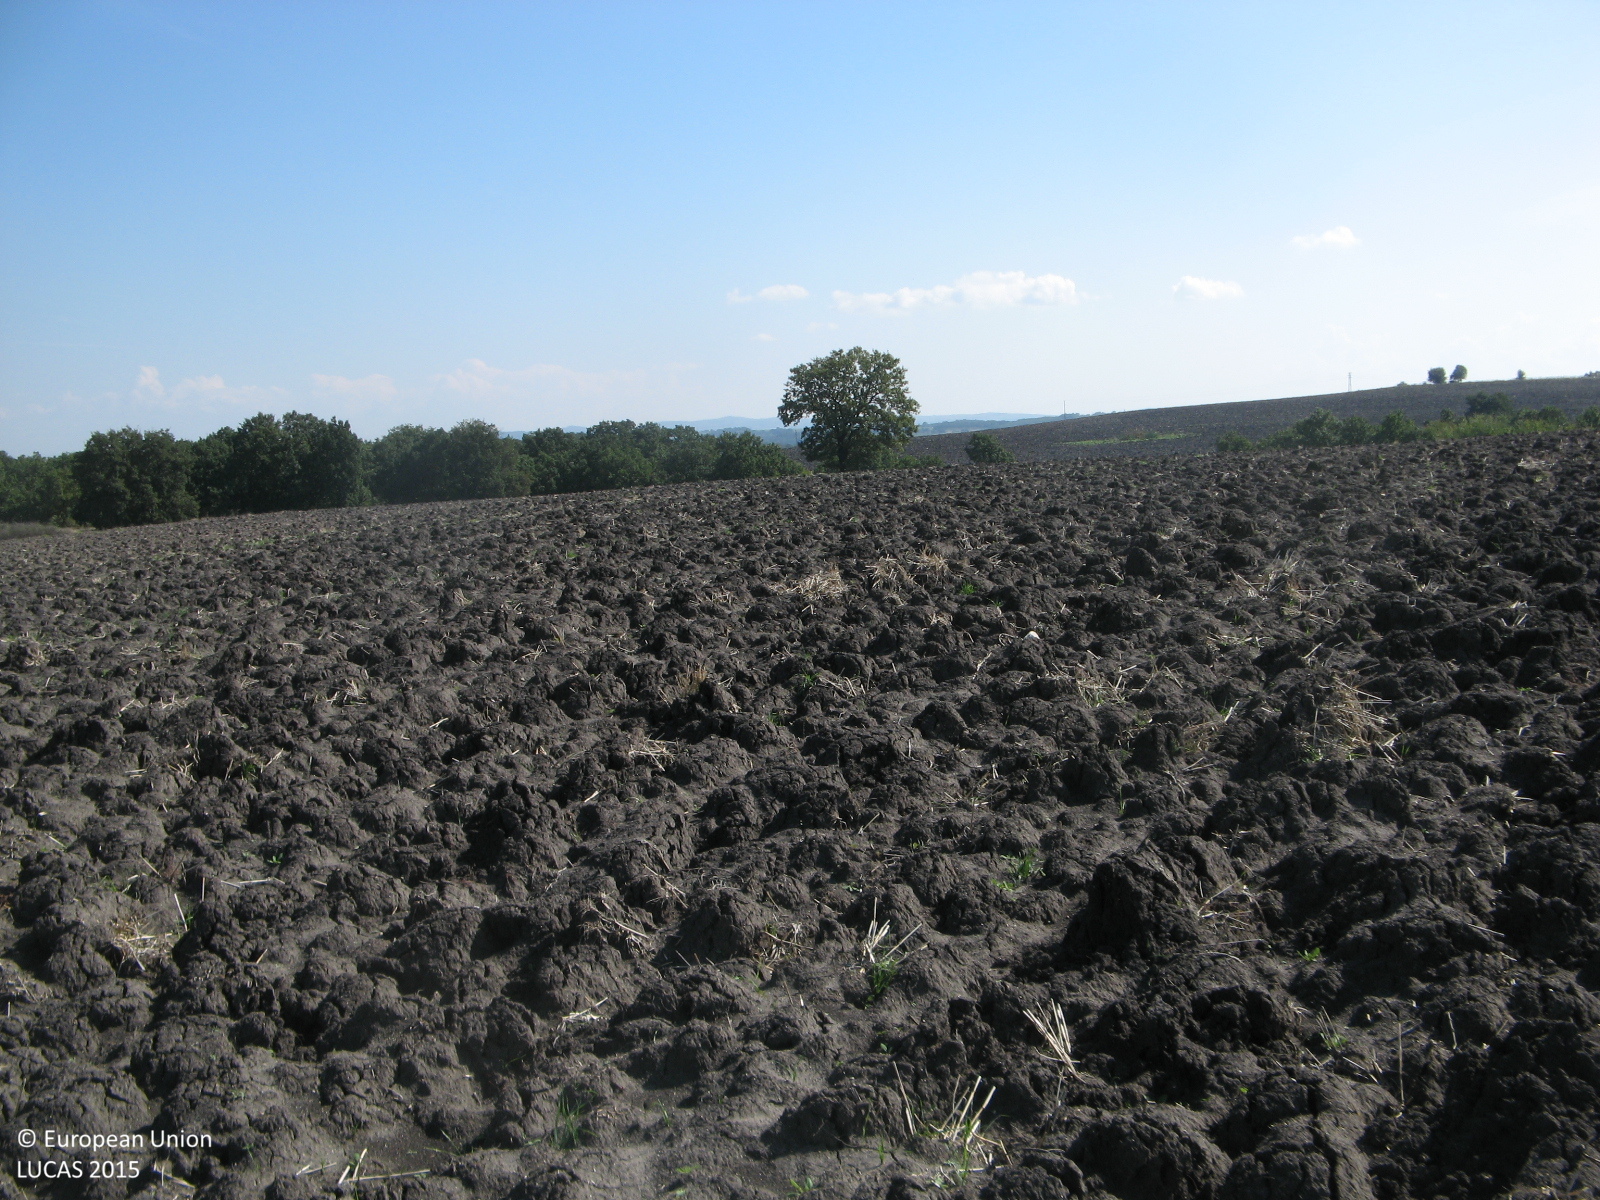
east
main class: Cropland
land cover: Common wheat
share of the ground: < 10 %
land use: Agriculture (excluding fallow land and kitchen gardens)
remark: Harvested field
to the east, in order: Common wheat; Grassland with sparse tree/shrub cover; Shrubland with sparse tree cover; Broadleaved woodland
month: October
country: BG
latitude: 41.9131
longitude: 25.6057
